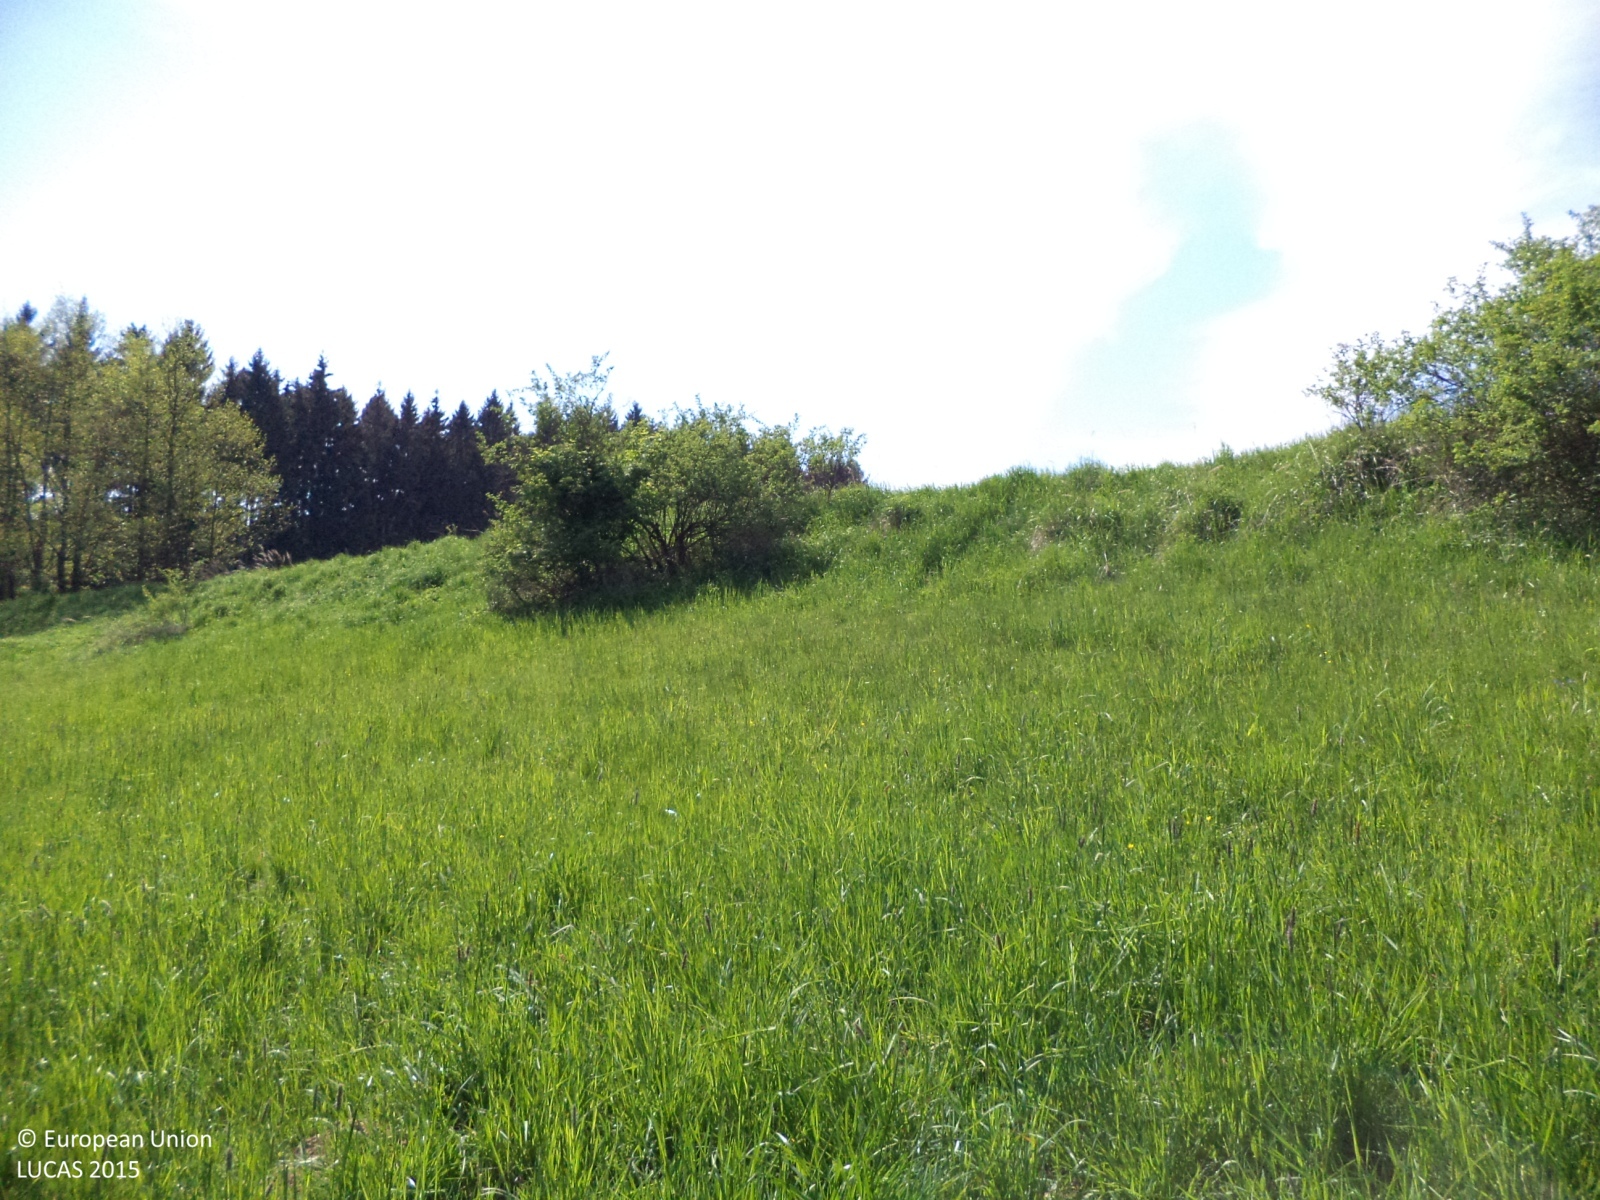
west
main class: Grassland
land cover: Grassland without tree/shrub cover
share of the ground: > 75 %
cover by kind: herbaceous plants 100 %
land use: Agriculture (excluding fallow land and kitchen gardens)
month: May
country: CZ
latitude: 49.4219
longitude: 15.0897
